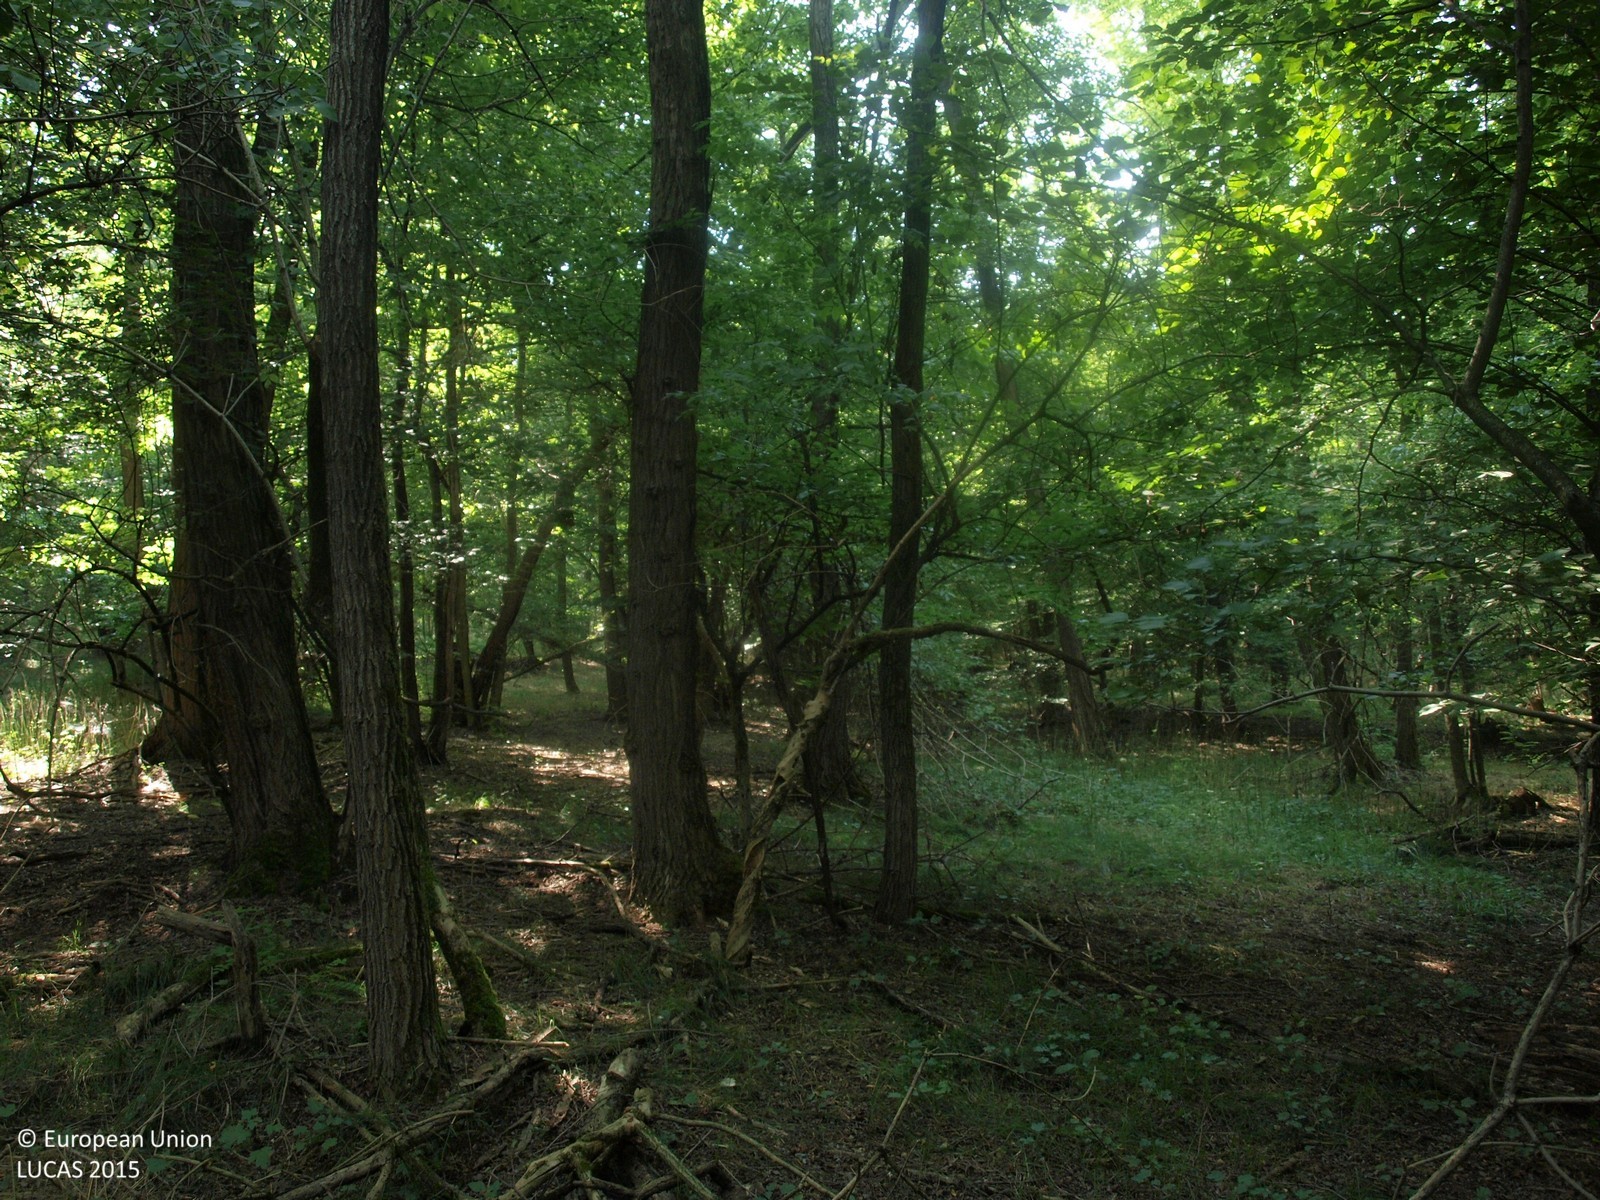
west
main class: Woodland
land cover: Broadleaved woodland
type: mesophytic deciduous forest
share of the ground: > 75 %
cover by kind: broadleaved forest trees 100 %
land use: Forestry
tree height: > 5 m
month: August
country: HR
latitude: 45.9621
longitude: 16.6713
